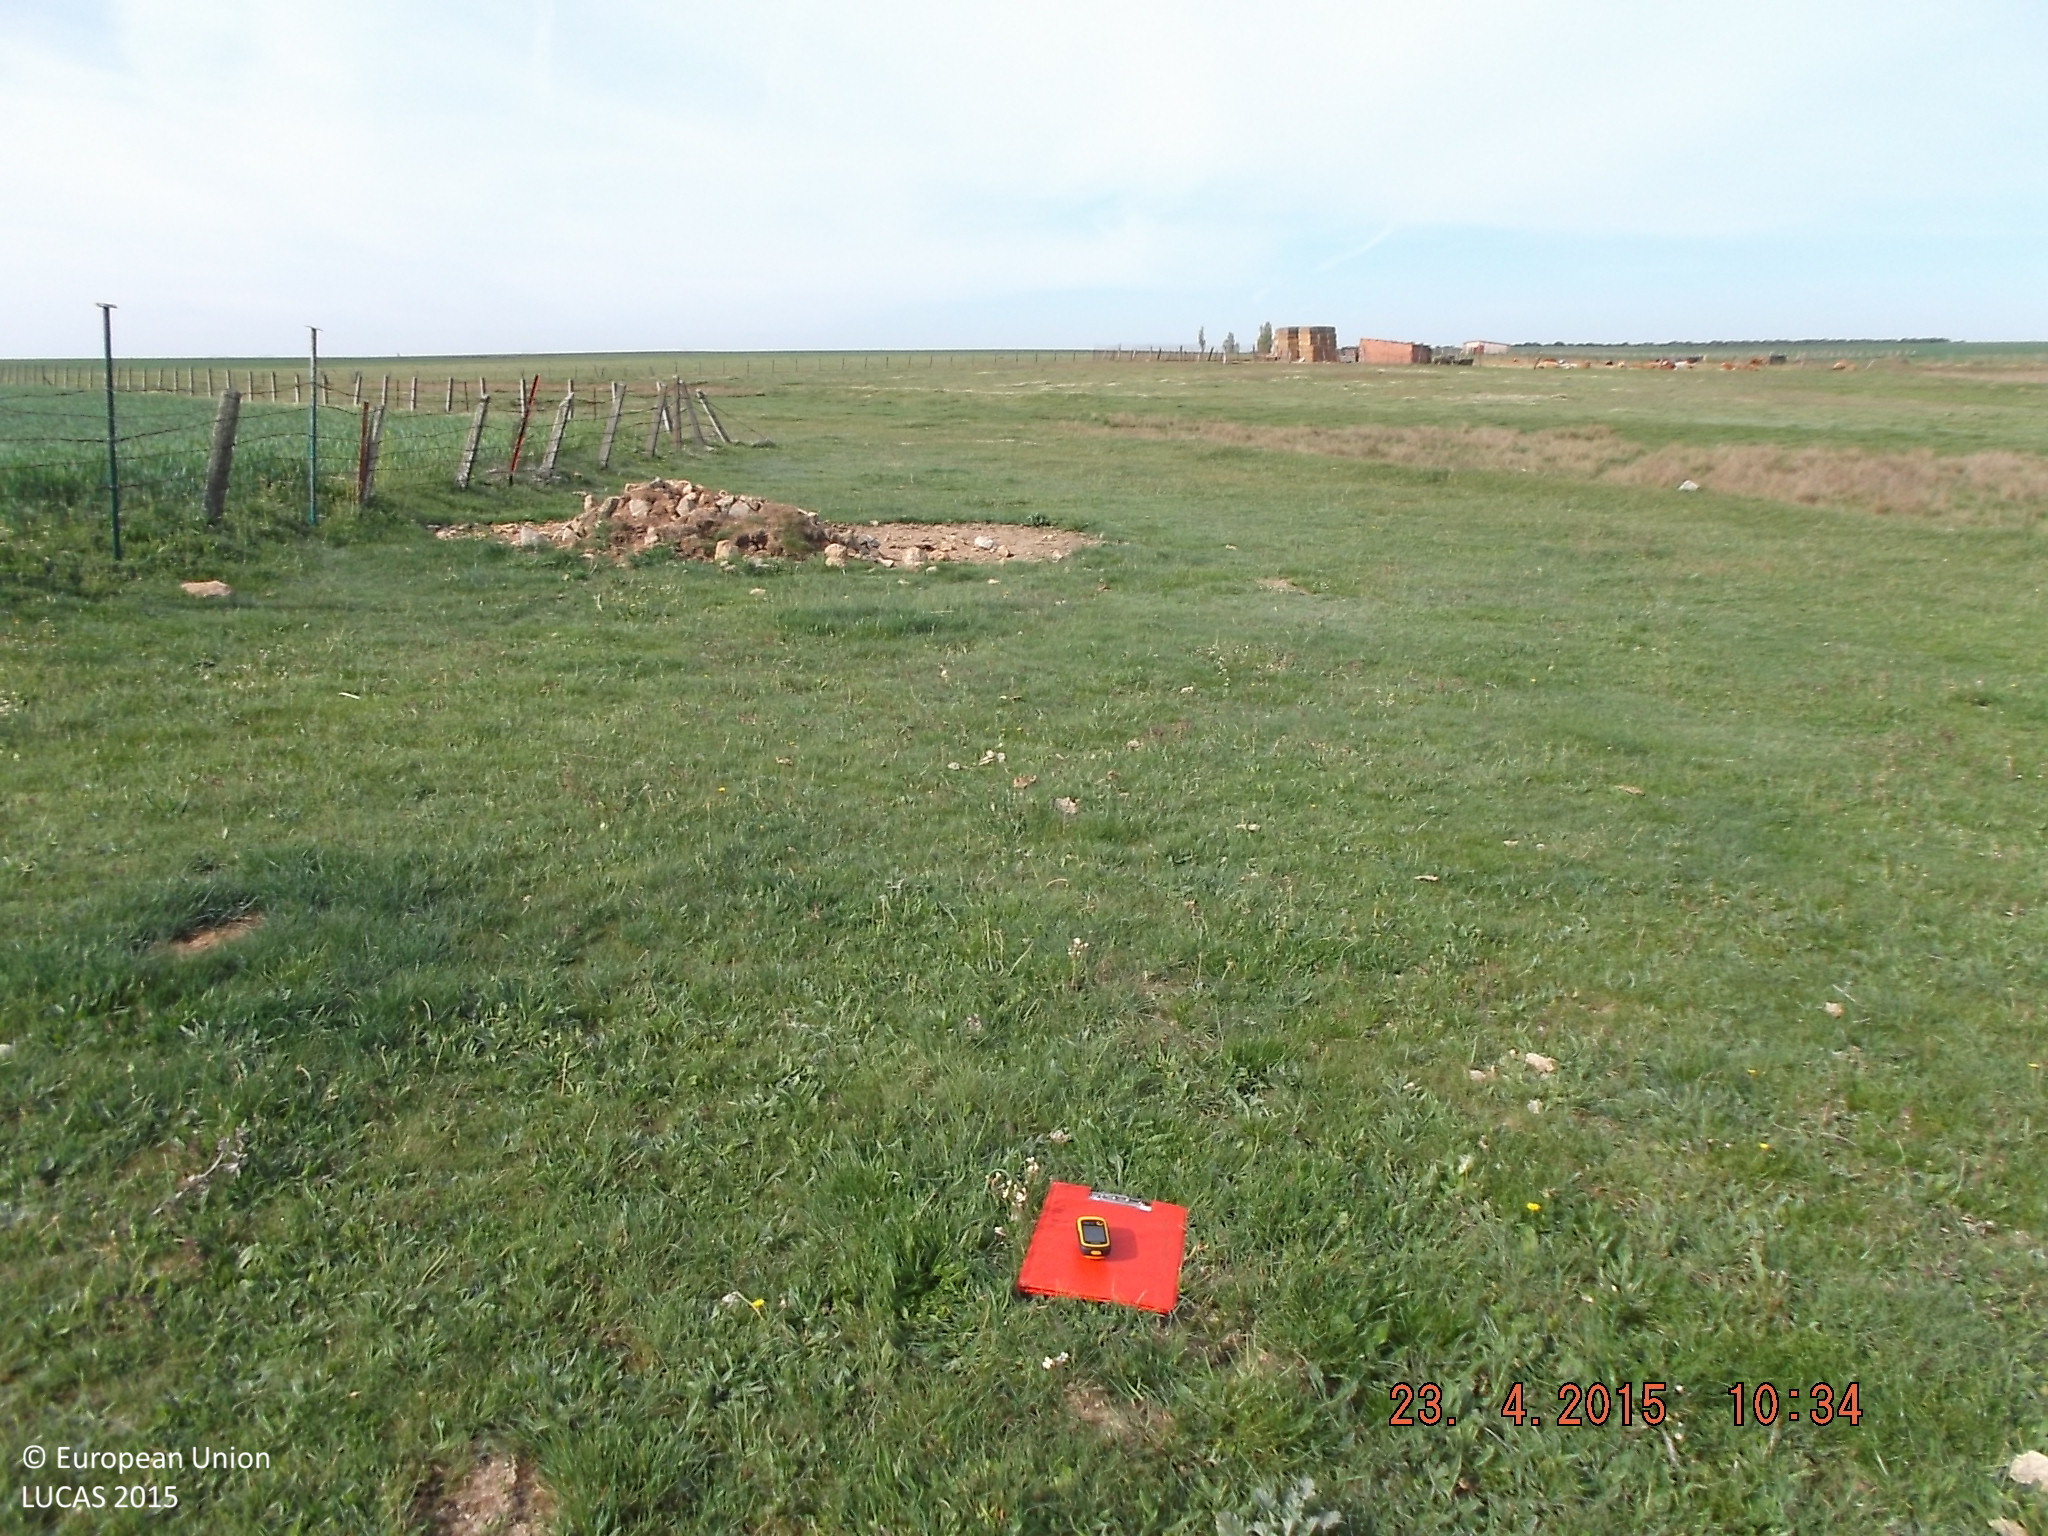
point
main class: Grassland
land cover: Grassland without tree/shrub cover
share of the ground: > 75 %
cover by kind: herbaceous plants 100 %
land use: Agriculture (excluding fallow land and kitchen gardens)
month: April
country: ES
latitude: 40.9450
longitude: -5.9162
